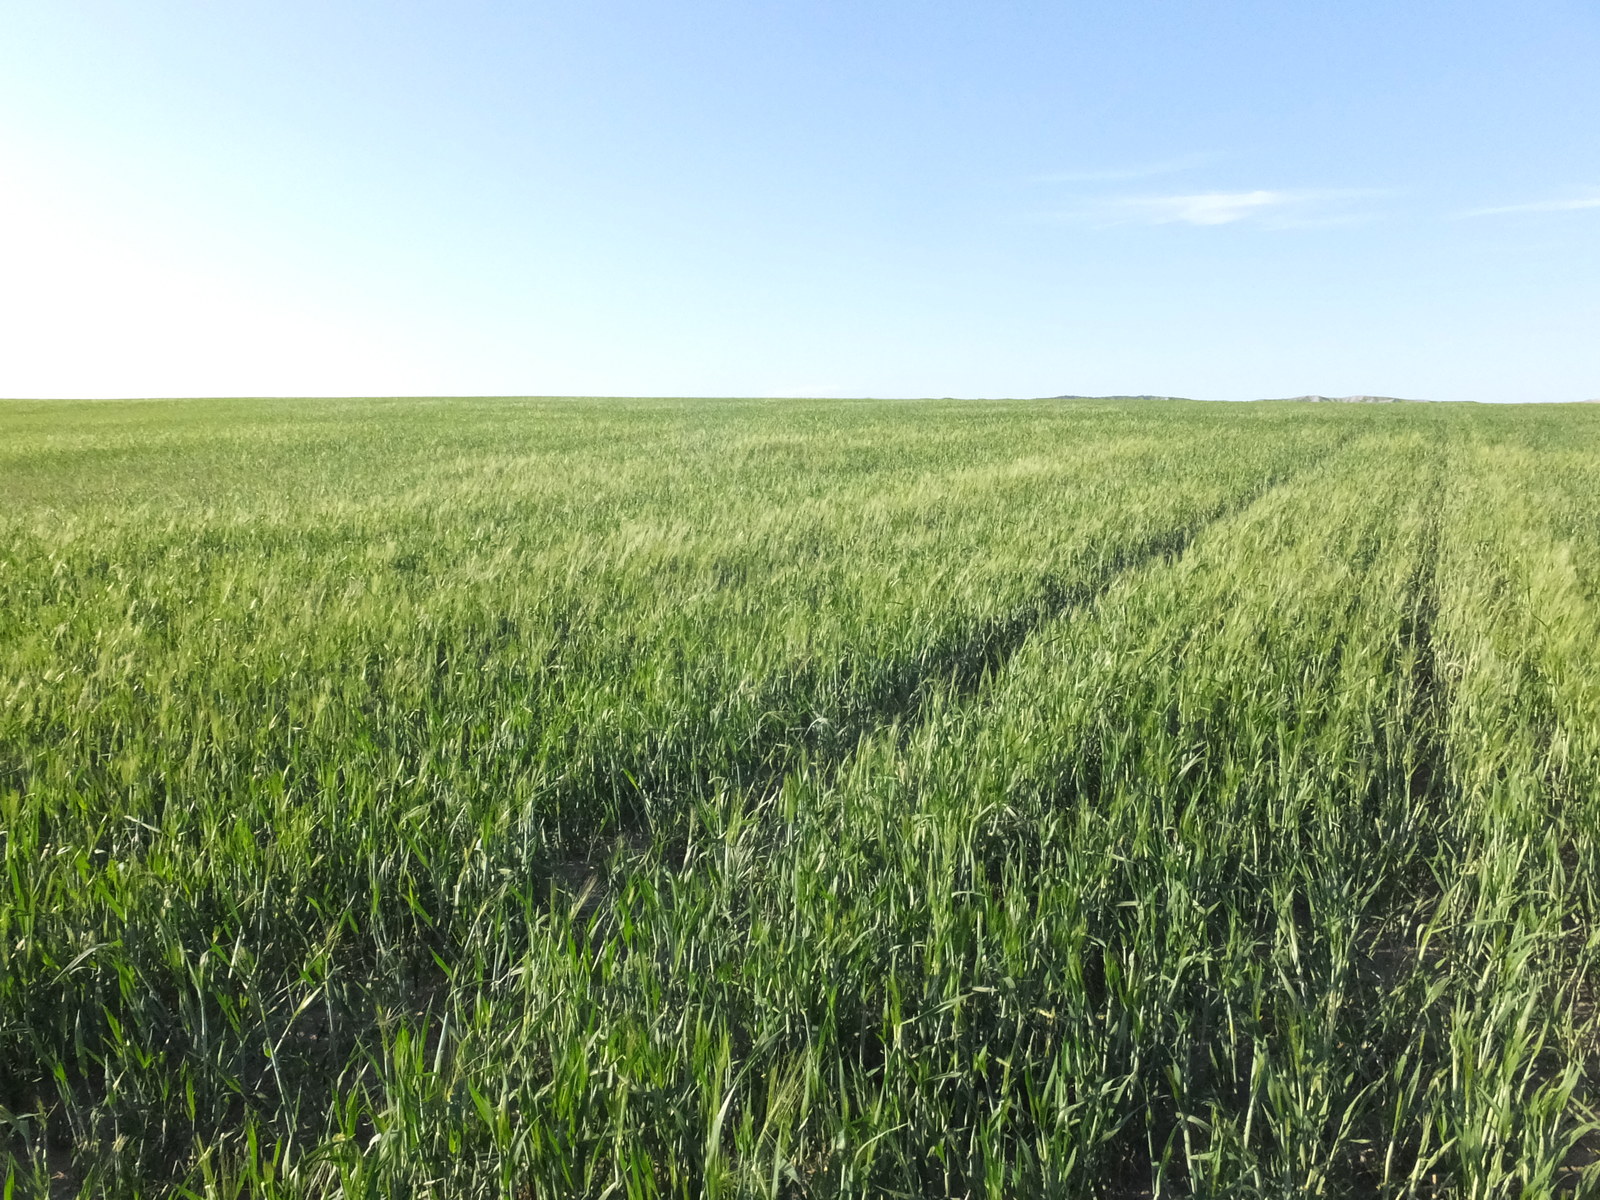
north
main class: Cropland
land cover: Durum wheat
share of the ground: > 75 %
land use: Agriculture (excluding fallow land and kitchen gardens)
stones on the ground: < 10 %
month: April
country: ES
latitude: 41.5462
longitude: -0.2904
